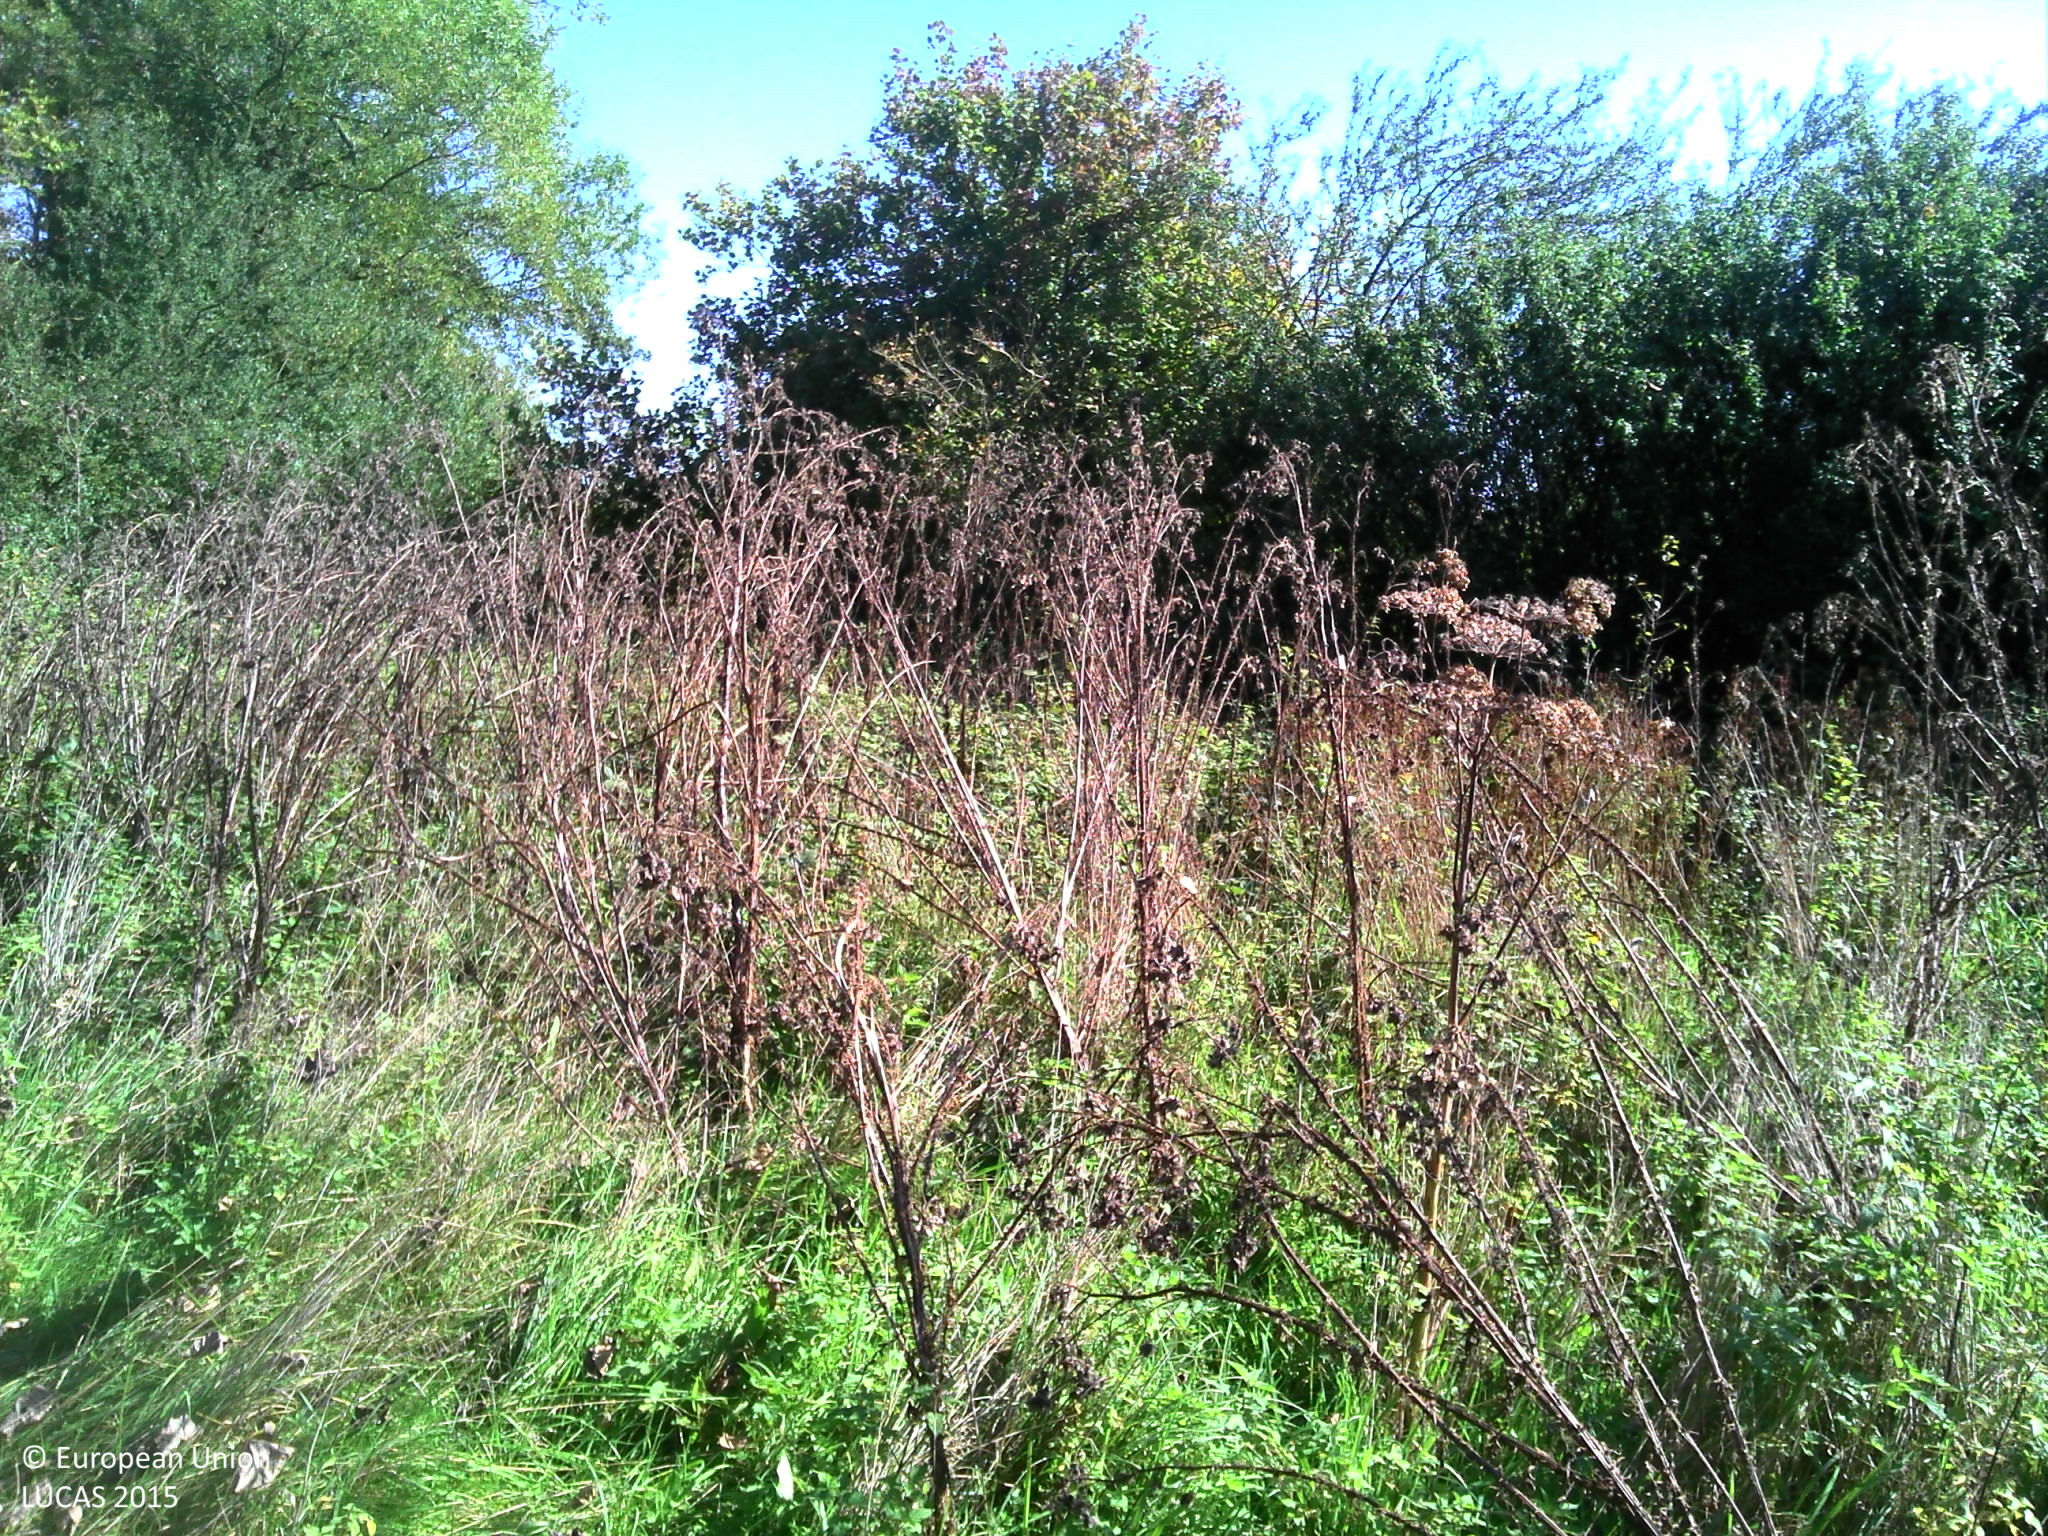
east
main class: Grassland
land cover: Spontaneously vegetated surfaces
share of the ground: > 75 %
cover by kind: herbaceous plants 100 %
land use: Semi-natural and natural areas not in use
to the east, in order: Spontaneously vegetated surfaces; Abandoned hedges; Fences; Grassland without tree/shrub cover; Ditches and canals; Grassland without tree/shrub cover
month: September
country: BE
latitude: 51.1829
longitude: 4.8035
